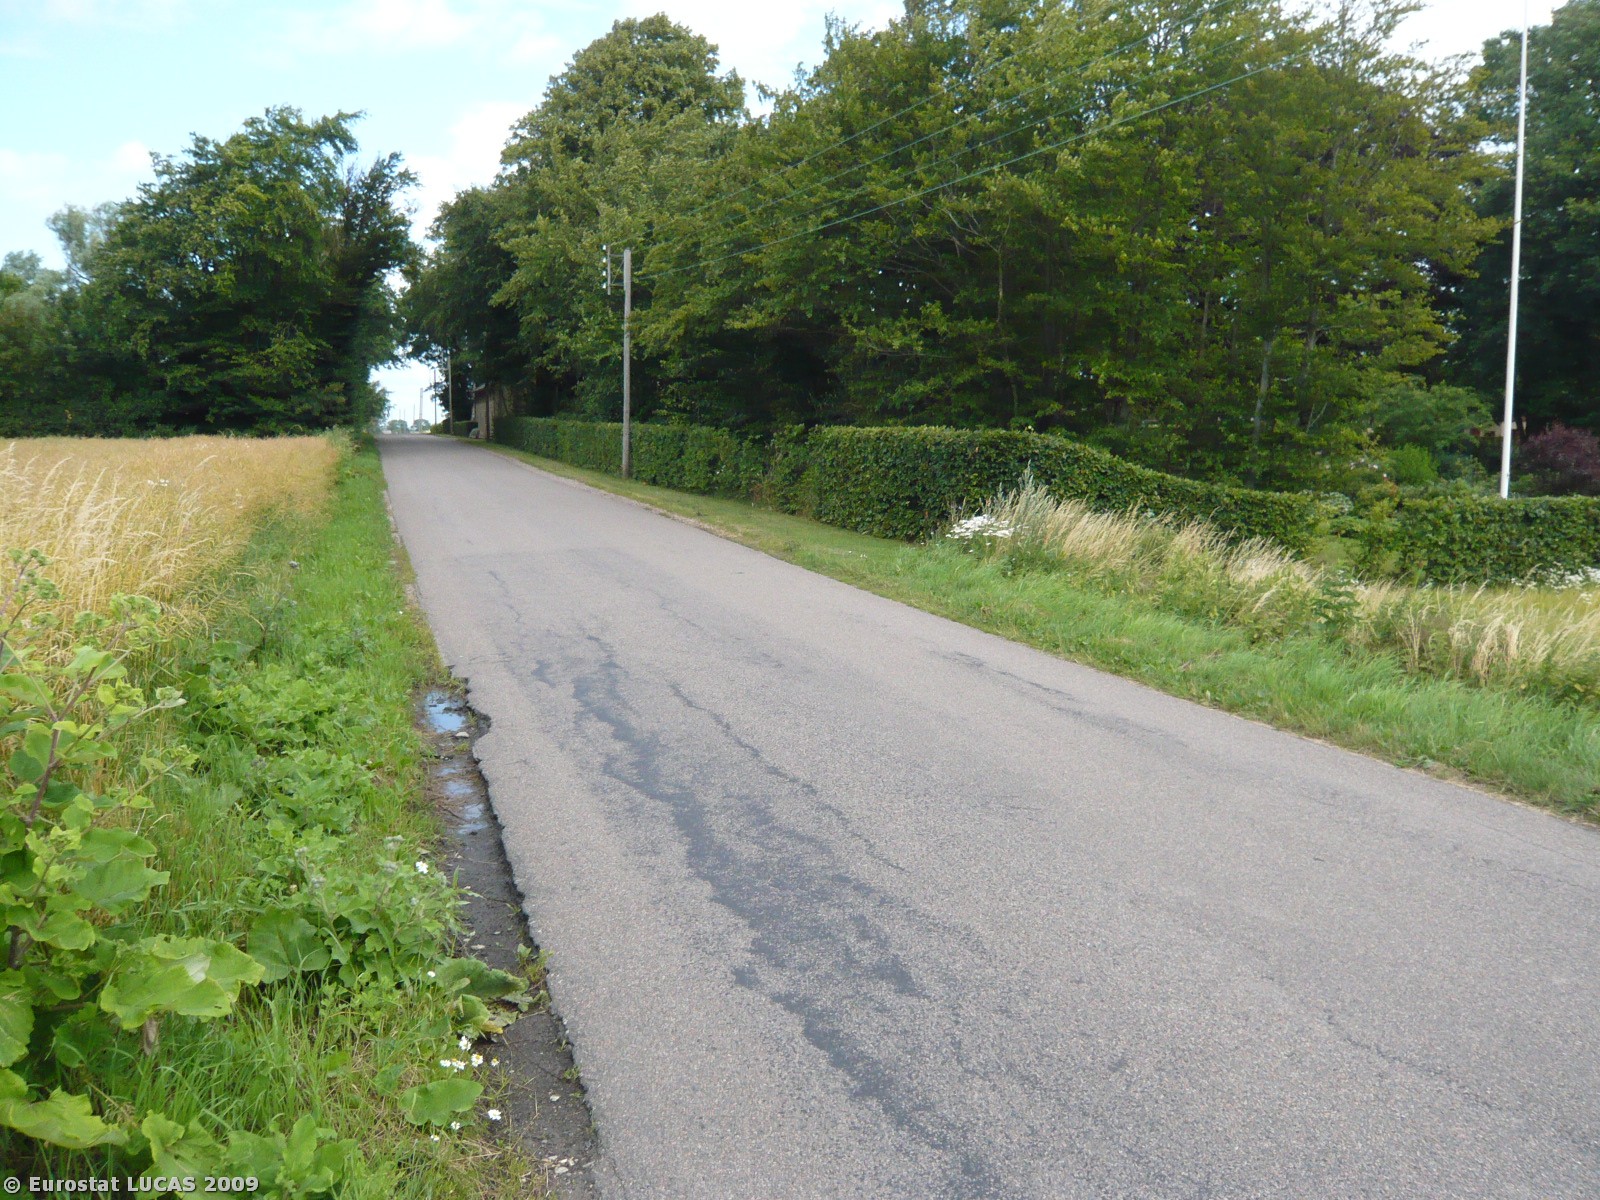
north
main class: Cropland
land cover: Rape and turnip rape
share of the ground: > 75 %
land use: Agriculture (excluding fallow land and kitchen gardens)
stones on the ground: < 10 %
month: July
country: DK
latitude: 55.5162
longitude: 11.2816
